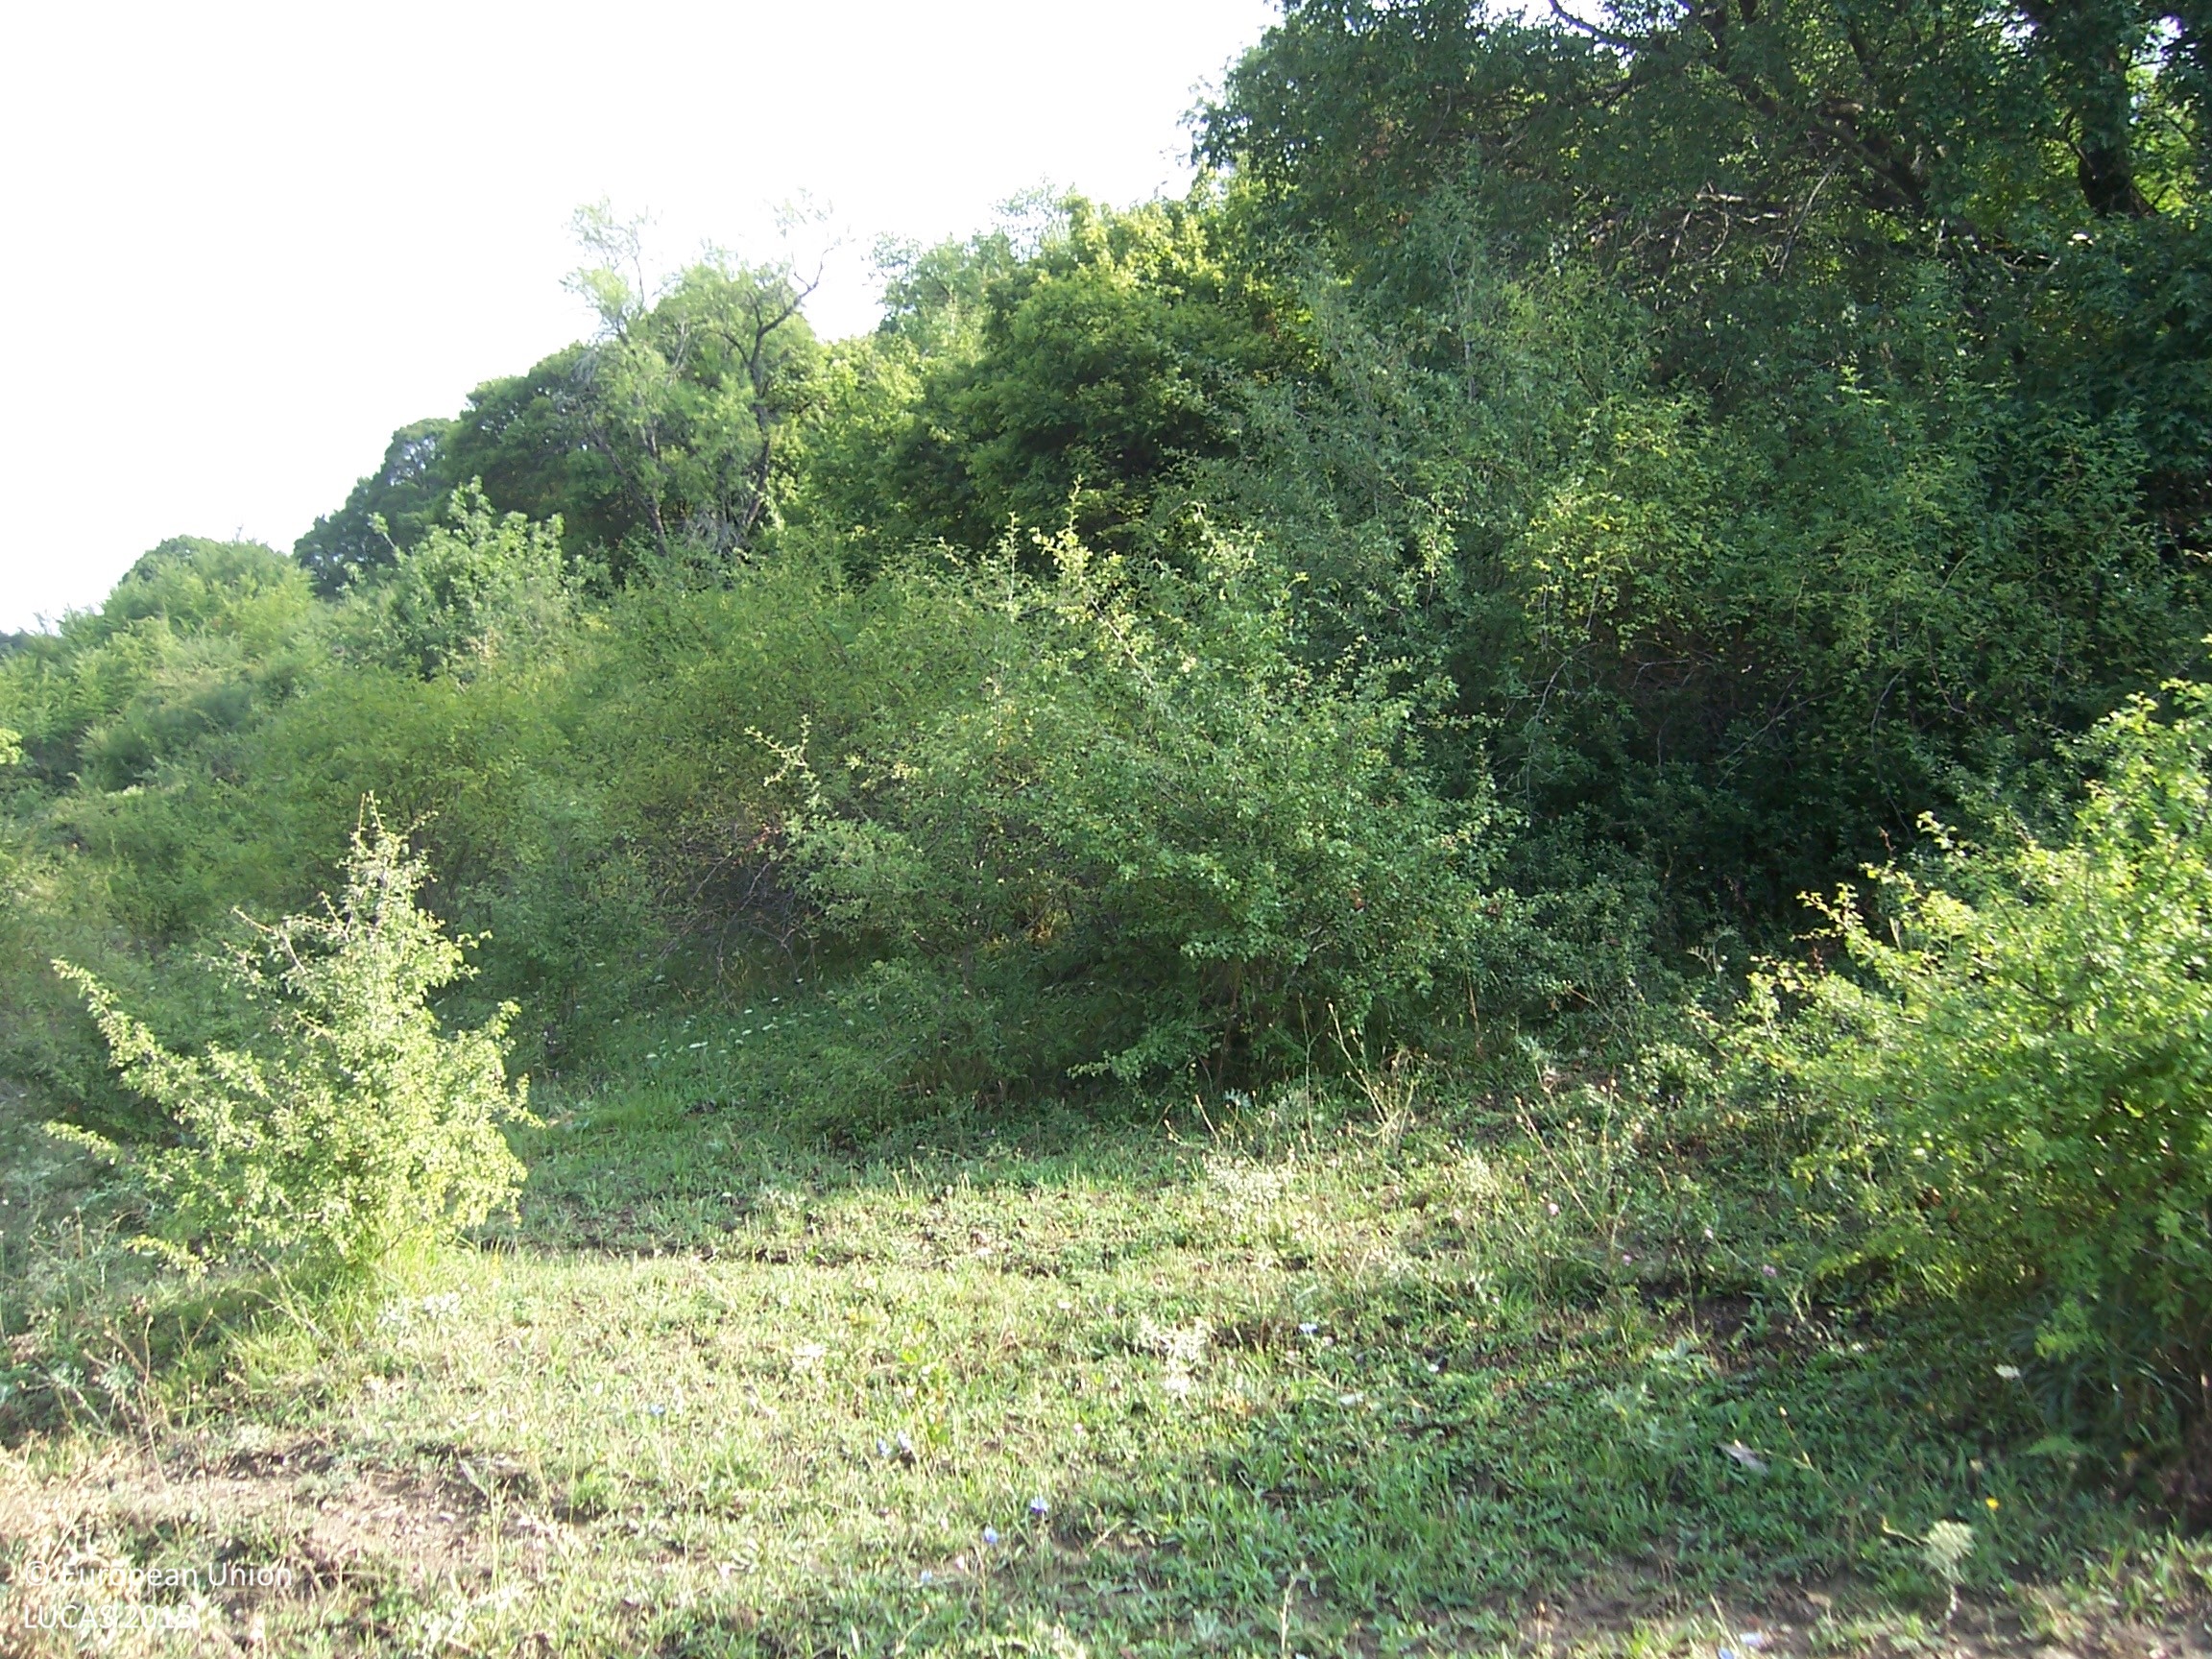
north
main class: Woodland
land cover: Broadleaved woodland
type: floodplain forest
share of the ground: > 75 %
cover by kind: broadleaved forest trees 50 %, herbaceous plants 20 %, consolidated bare surface 20 %, shrubs 10 %
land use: Semi-natural and natural areas not in use
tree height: > 5 m
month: August
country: ES
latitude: 42.6774
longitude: -0.4364
